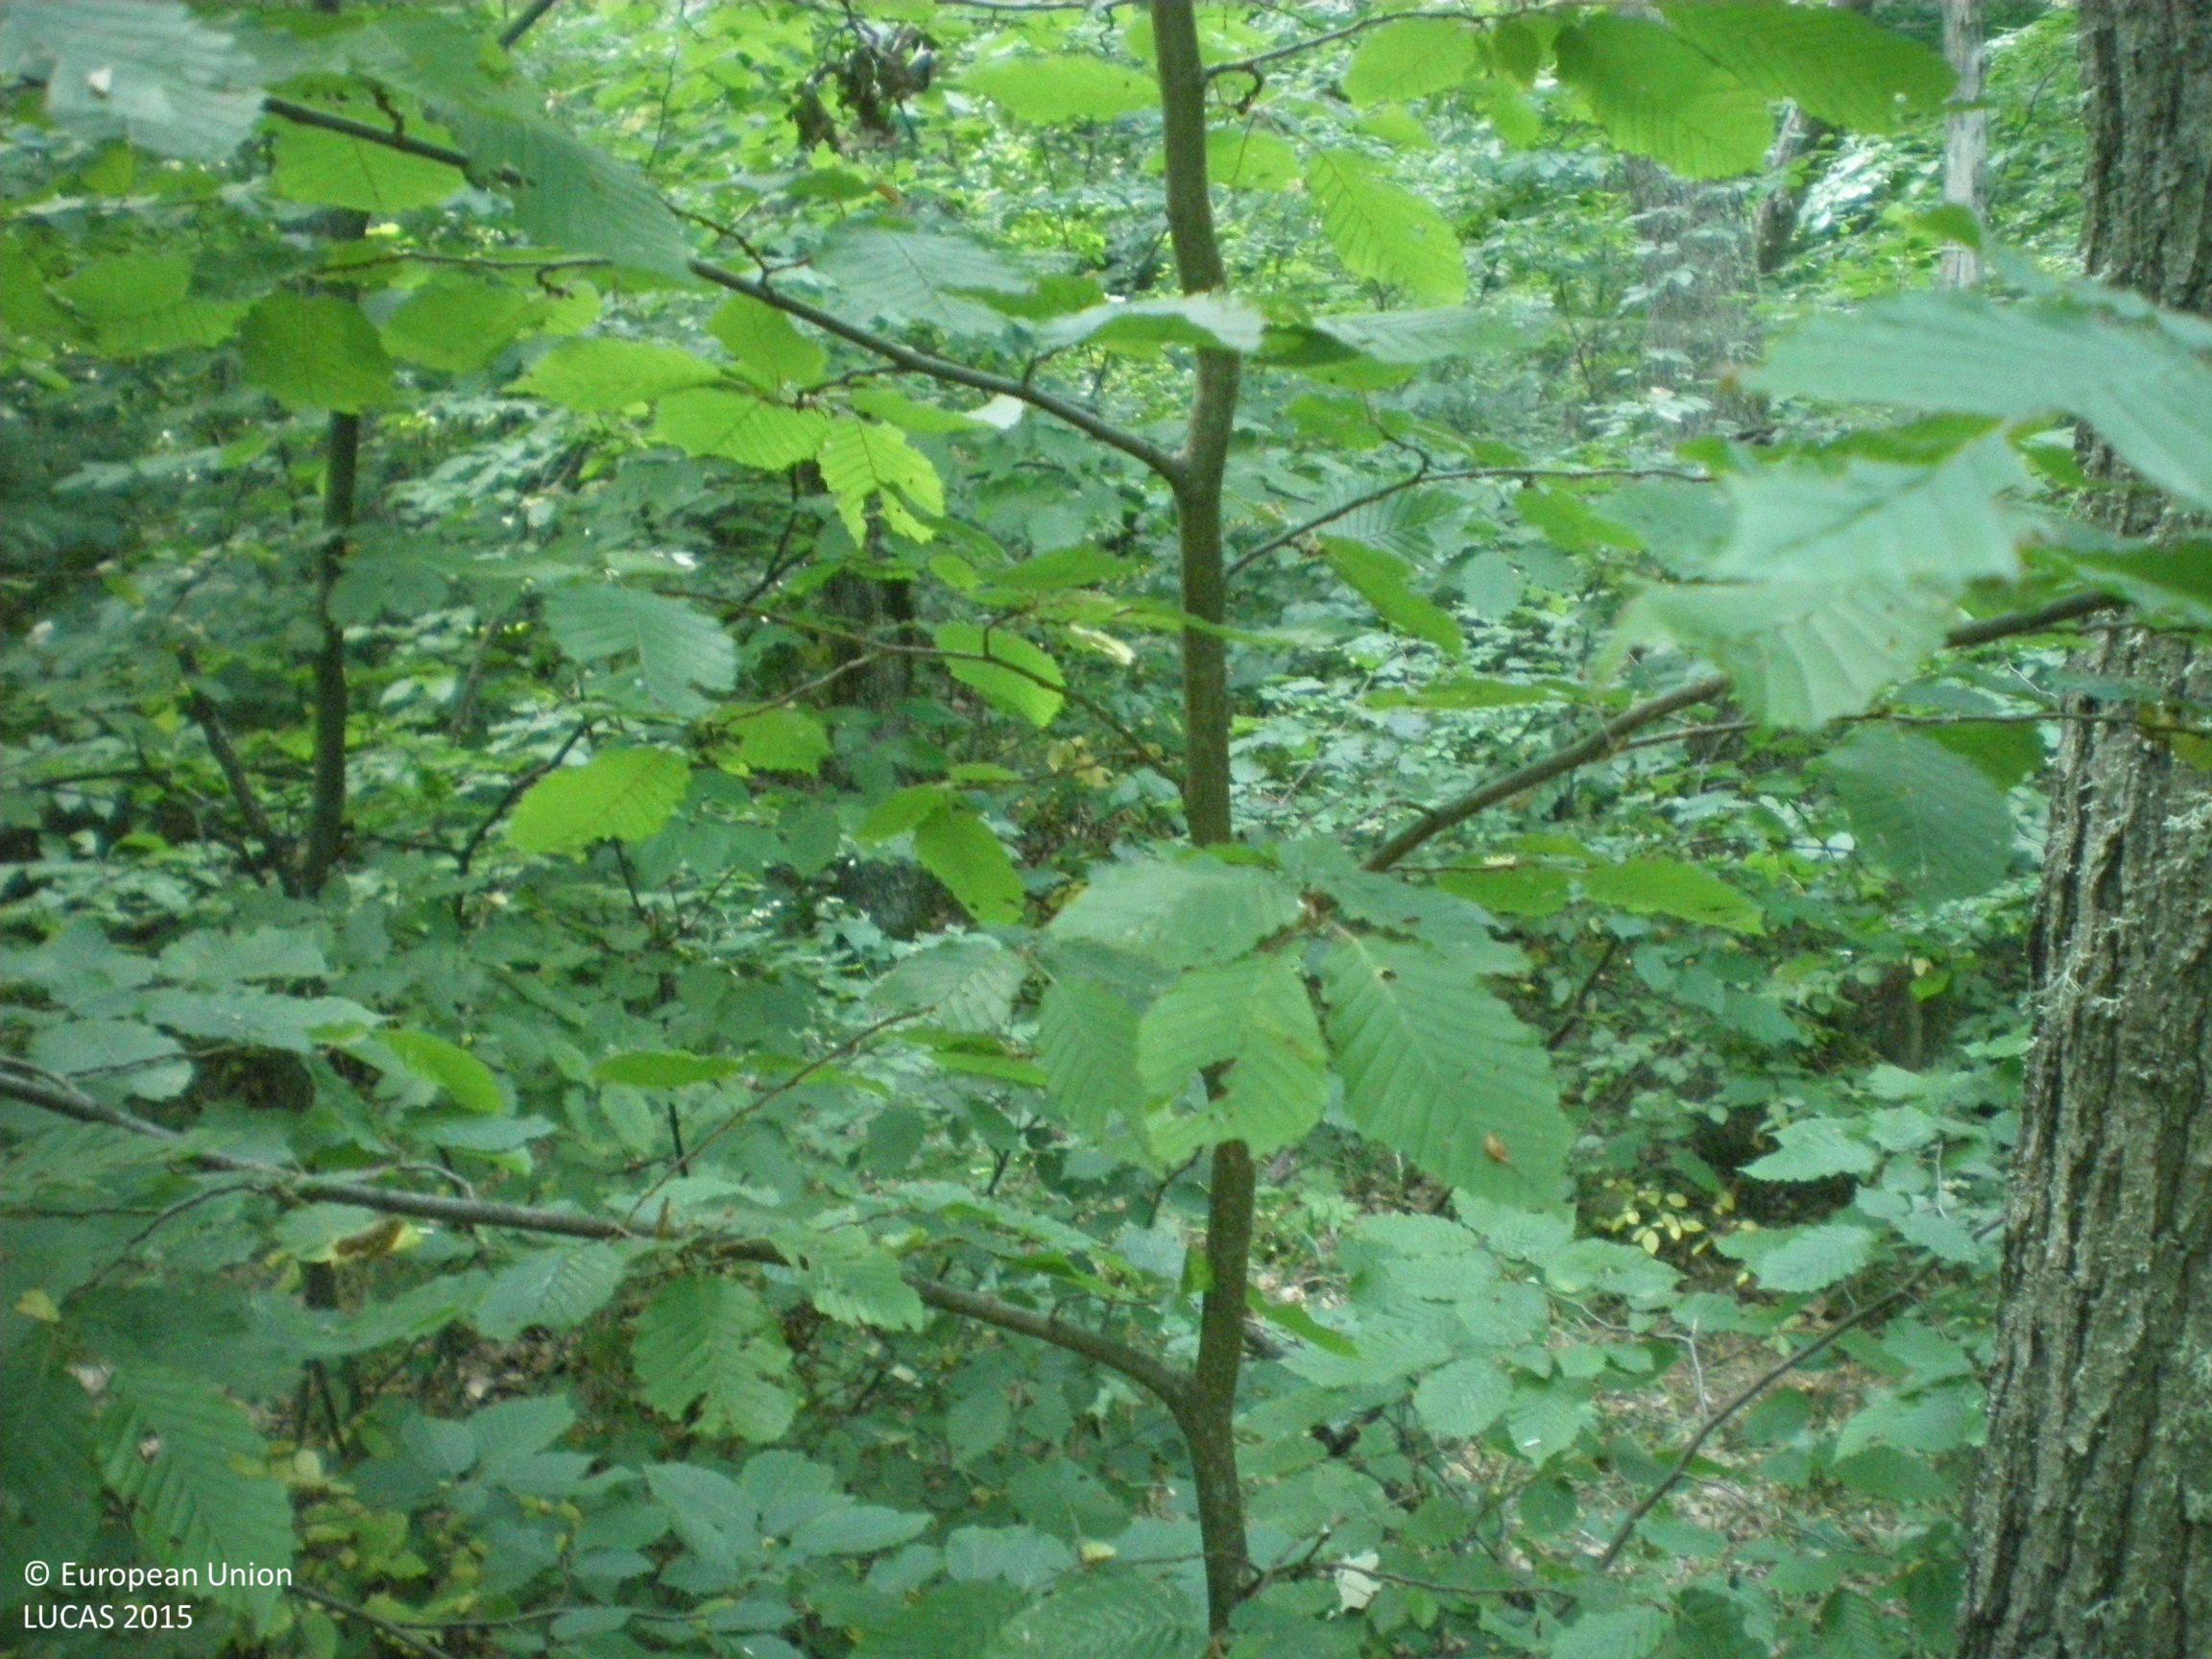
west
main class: Woodland
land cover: Broadleaved woodland
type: mesophytic deciduous forest
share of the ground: > 75 %
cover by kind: broadleaved forest trees 100 %
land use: Forestry
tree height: > 5 m
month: July
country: BG
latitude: 42.5517
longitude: 25.1530
